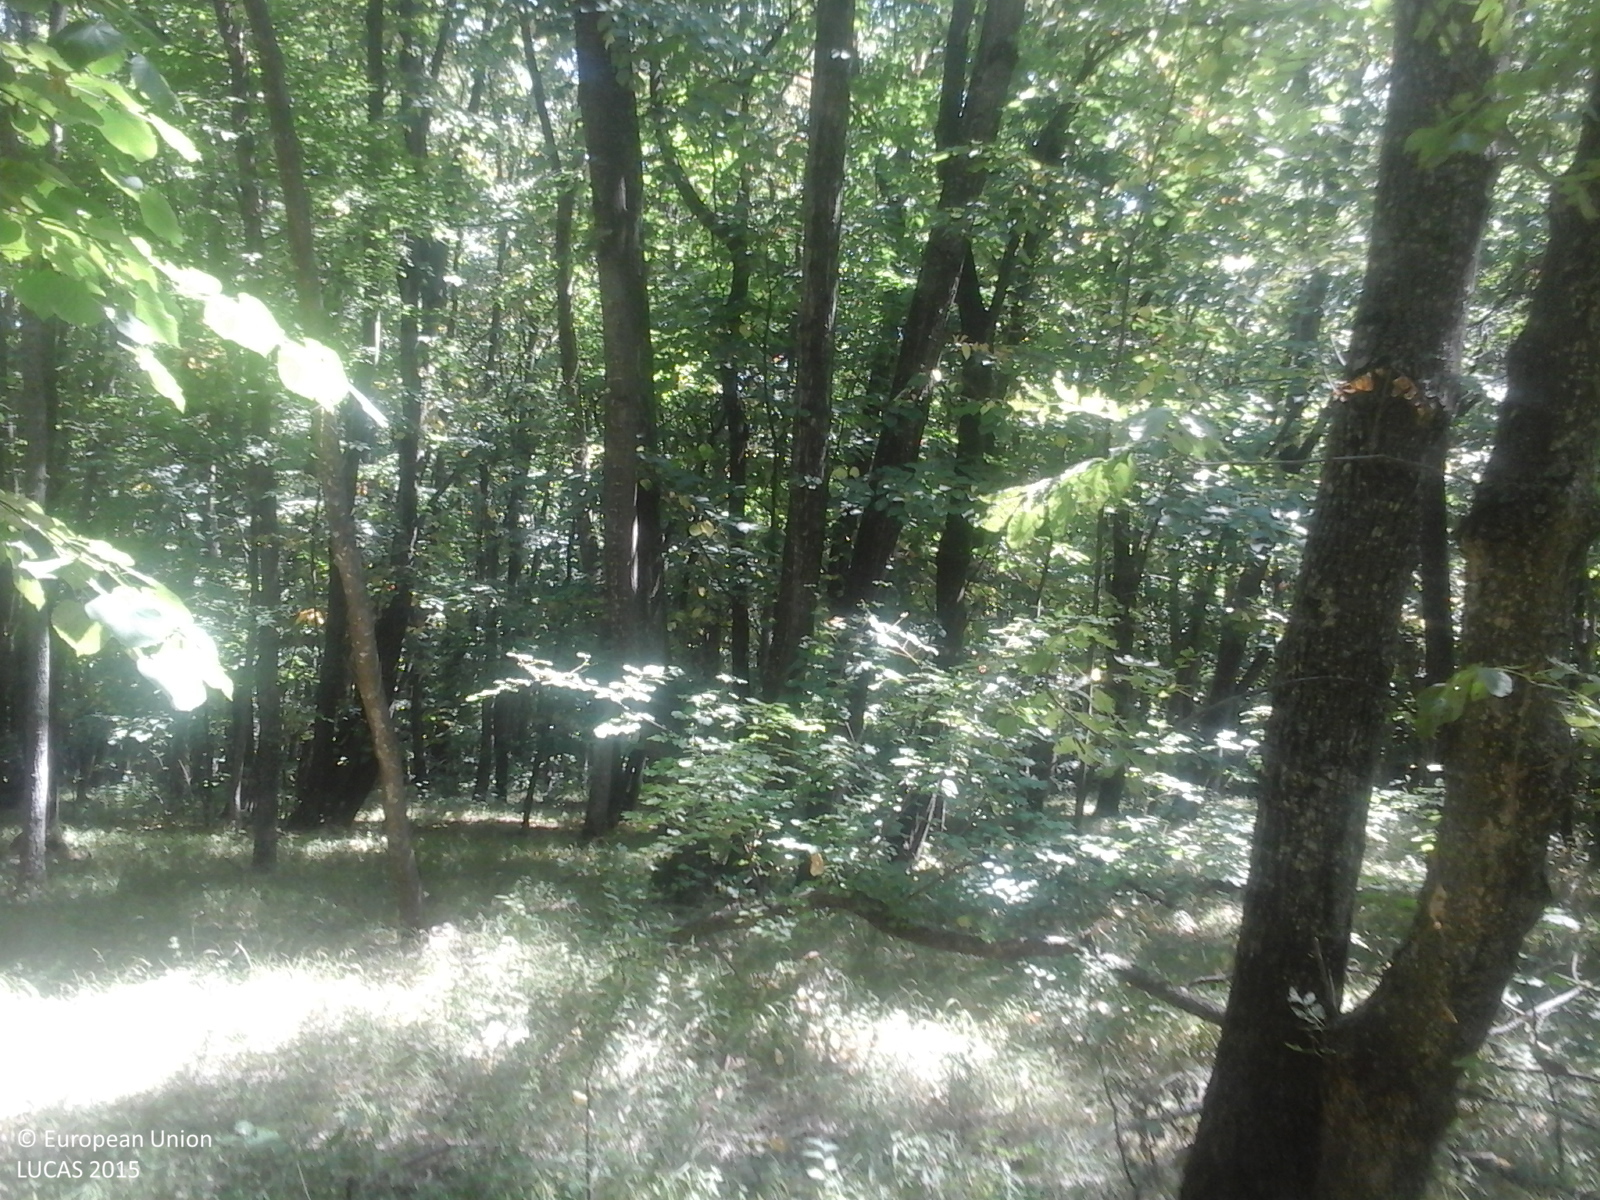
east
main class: Woodland
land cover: Broadleaved woodland
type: acidophilous oak and oak-birch forest
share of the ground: > 75 %
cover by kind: broadleaved forest trees 100 %
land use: Forestry
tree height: > 5 m
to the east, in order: Broadleaved woodland; Tracks; Broadleaved woodland; Tracks; Broadleaved woodland; Ditches and canals; Broadleaved woodland; Tracks; Broadleaved woodland
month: July
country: RO
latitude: 46.5096
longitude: 27.9670
